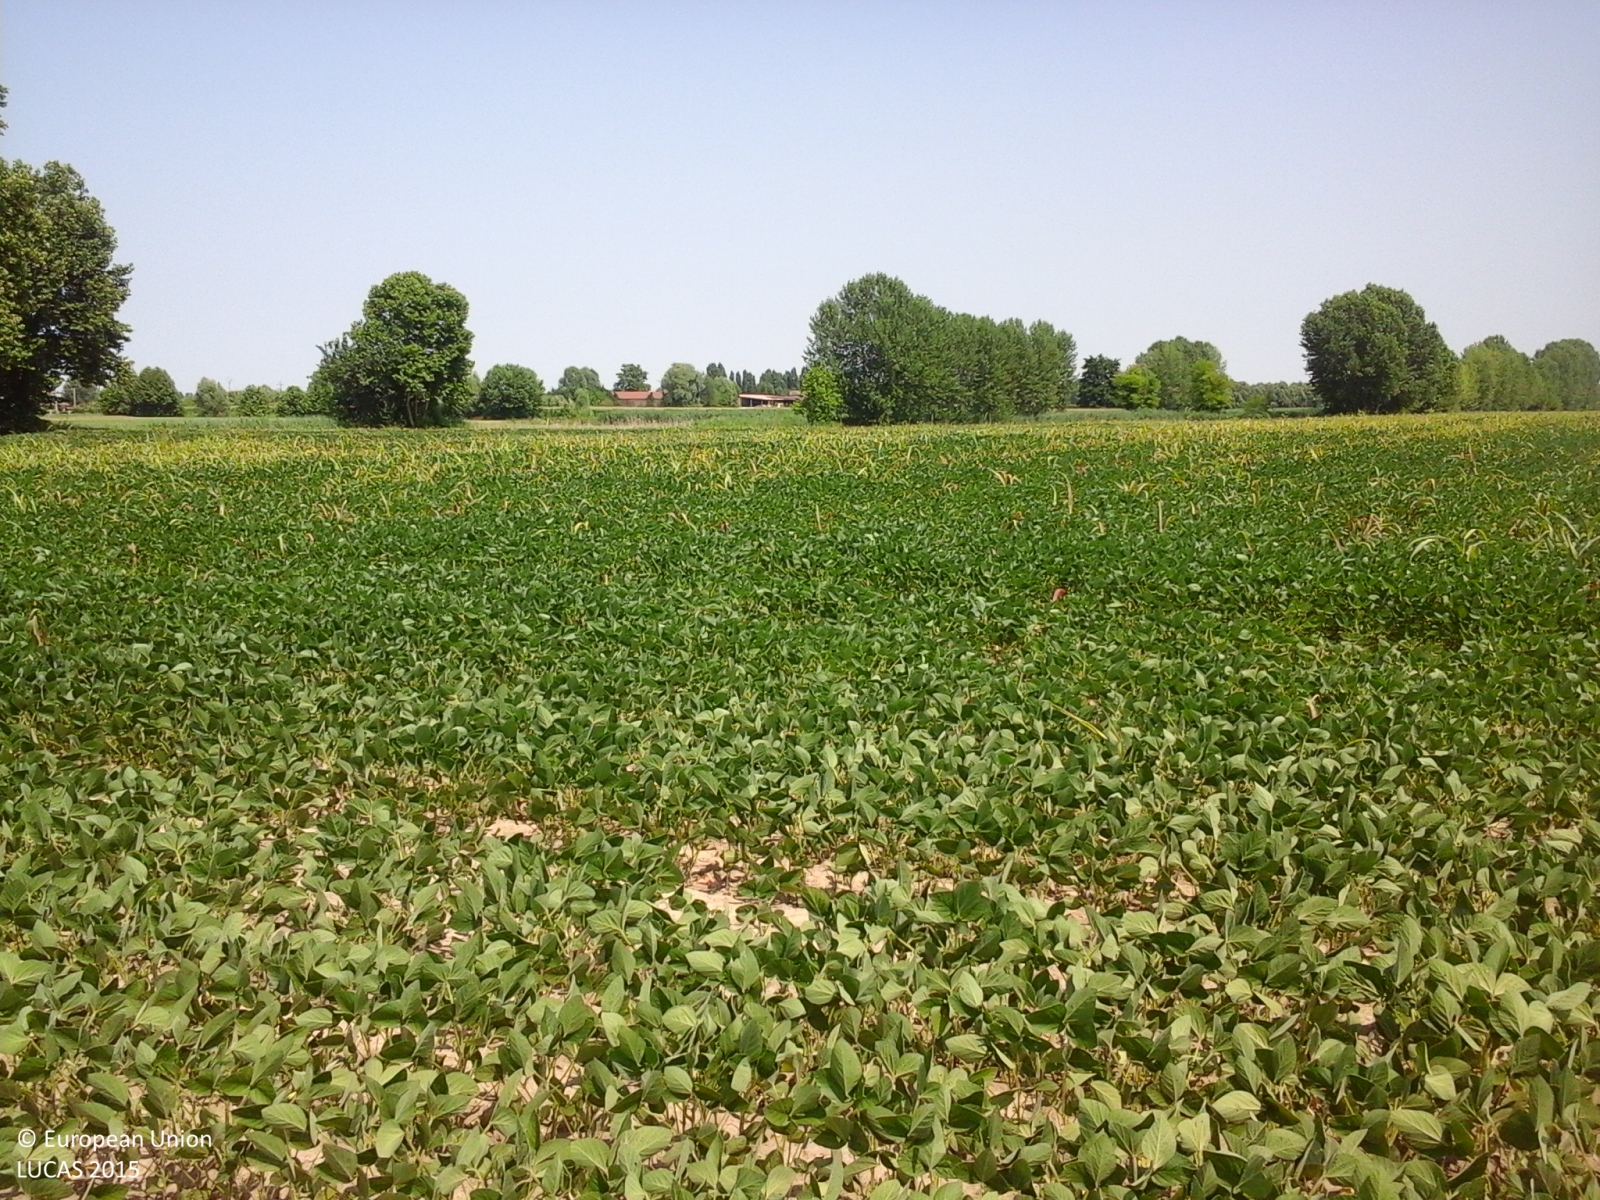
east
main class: Cropland
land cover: Barley
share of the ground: > 75 %
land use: Agriculture (excluding fallow land and kitchen gardens)
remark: Harvested field
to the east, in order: Ditches and canals; Soya; Managed hedges; Ditches and canals; Temporary grasslands
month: July
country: IT
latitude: 45.3383
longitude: 10.9044
